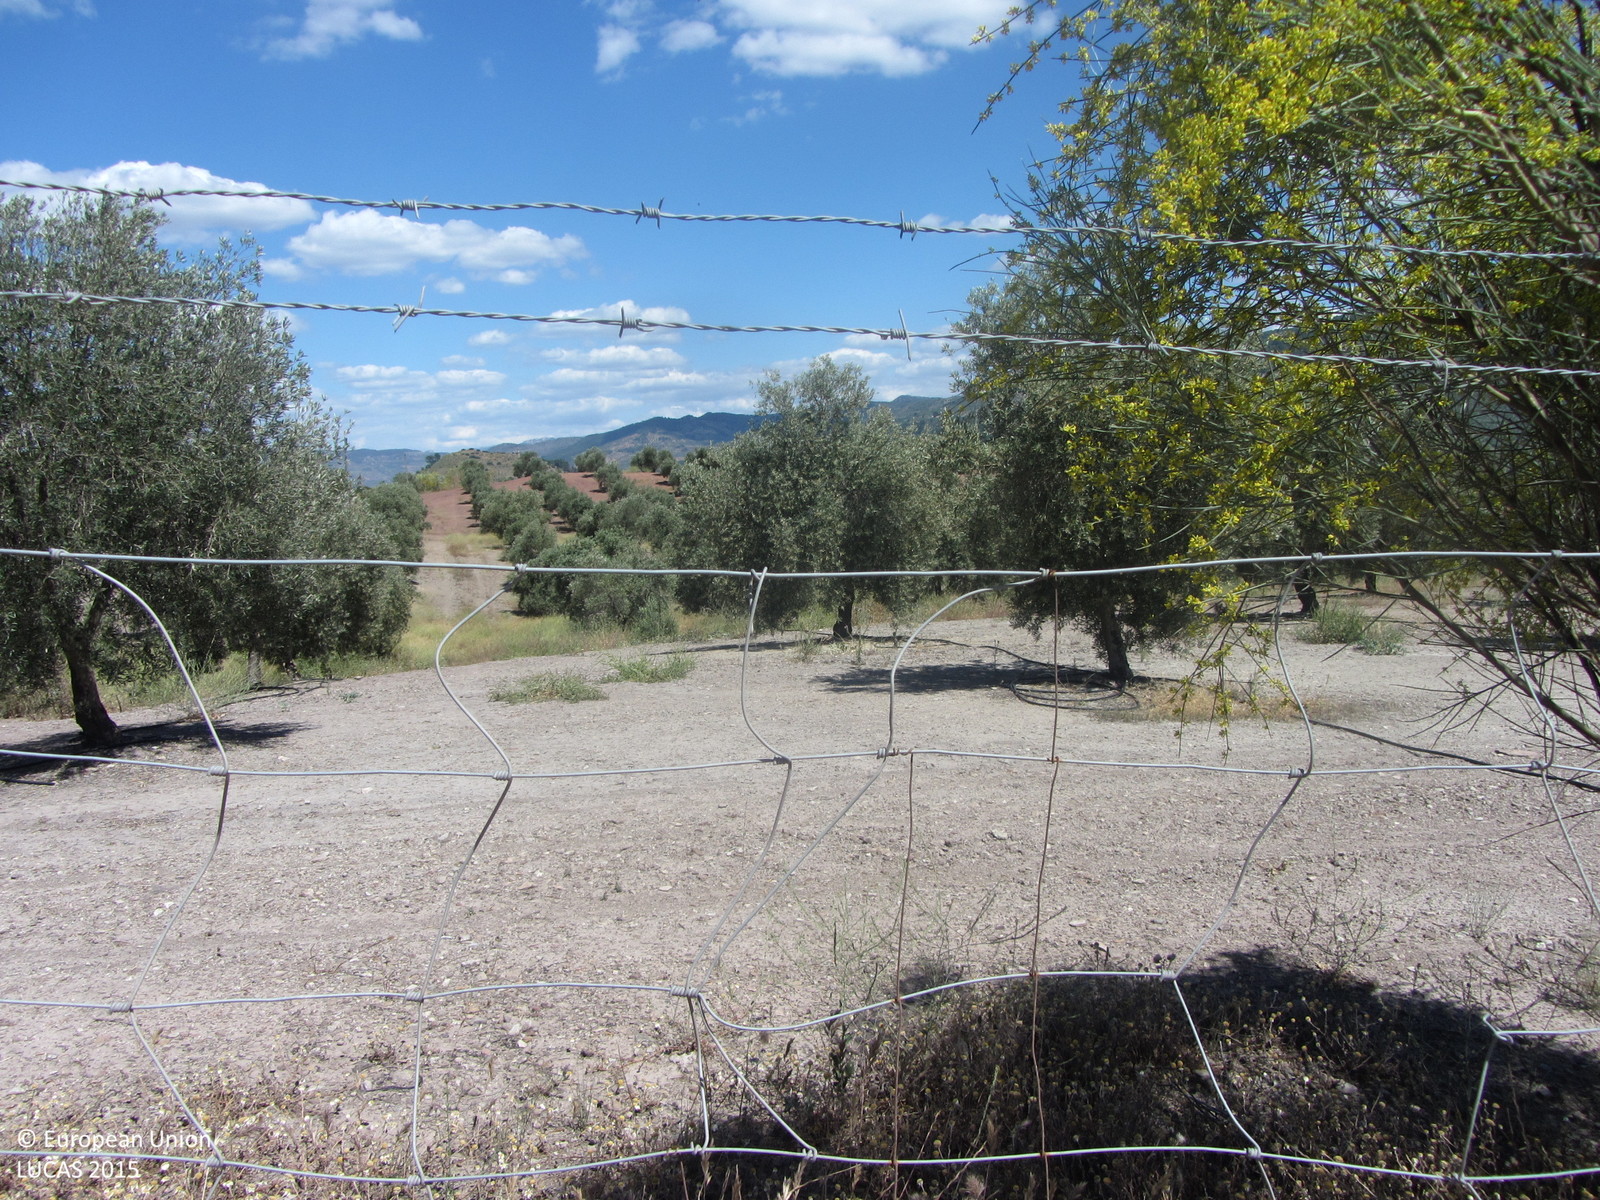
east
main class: Cropland
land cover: Olive groves
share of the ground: 25 - 50 %
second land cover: Other bare soil
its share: > 75 %
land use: Agriculture (excluding fallow land and kitchen gardens)
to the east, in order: Olive groves; Other bare soil; Other structural elements; Olive groves; Shruby margins; Fences; Tracks; Shrubland without tree cover; Paved roads, cycling and walking lanes; Groves; Fences; Olive groves; Fences; Olive groves
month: May
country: ES
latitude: 38.3534
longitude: -2.8738
